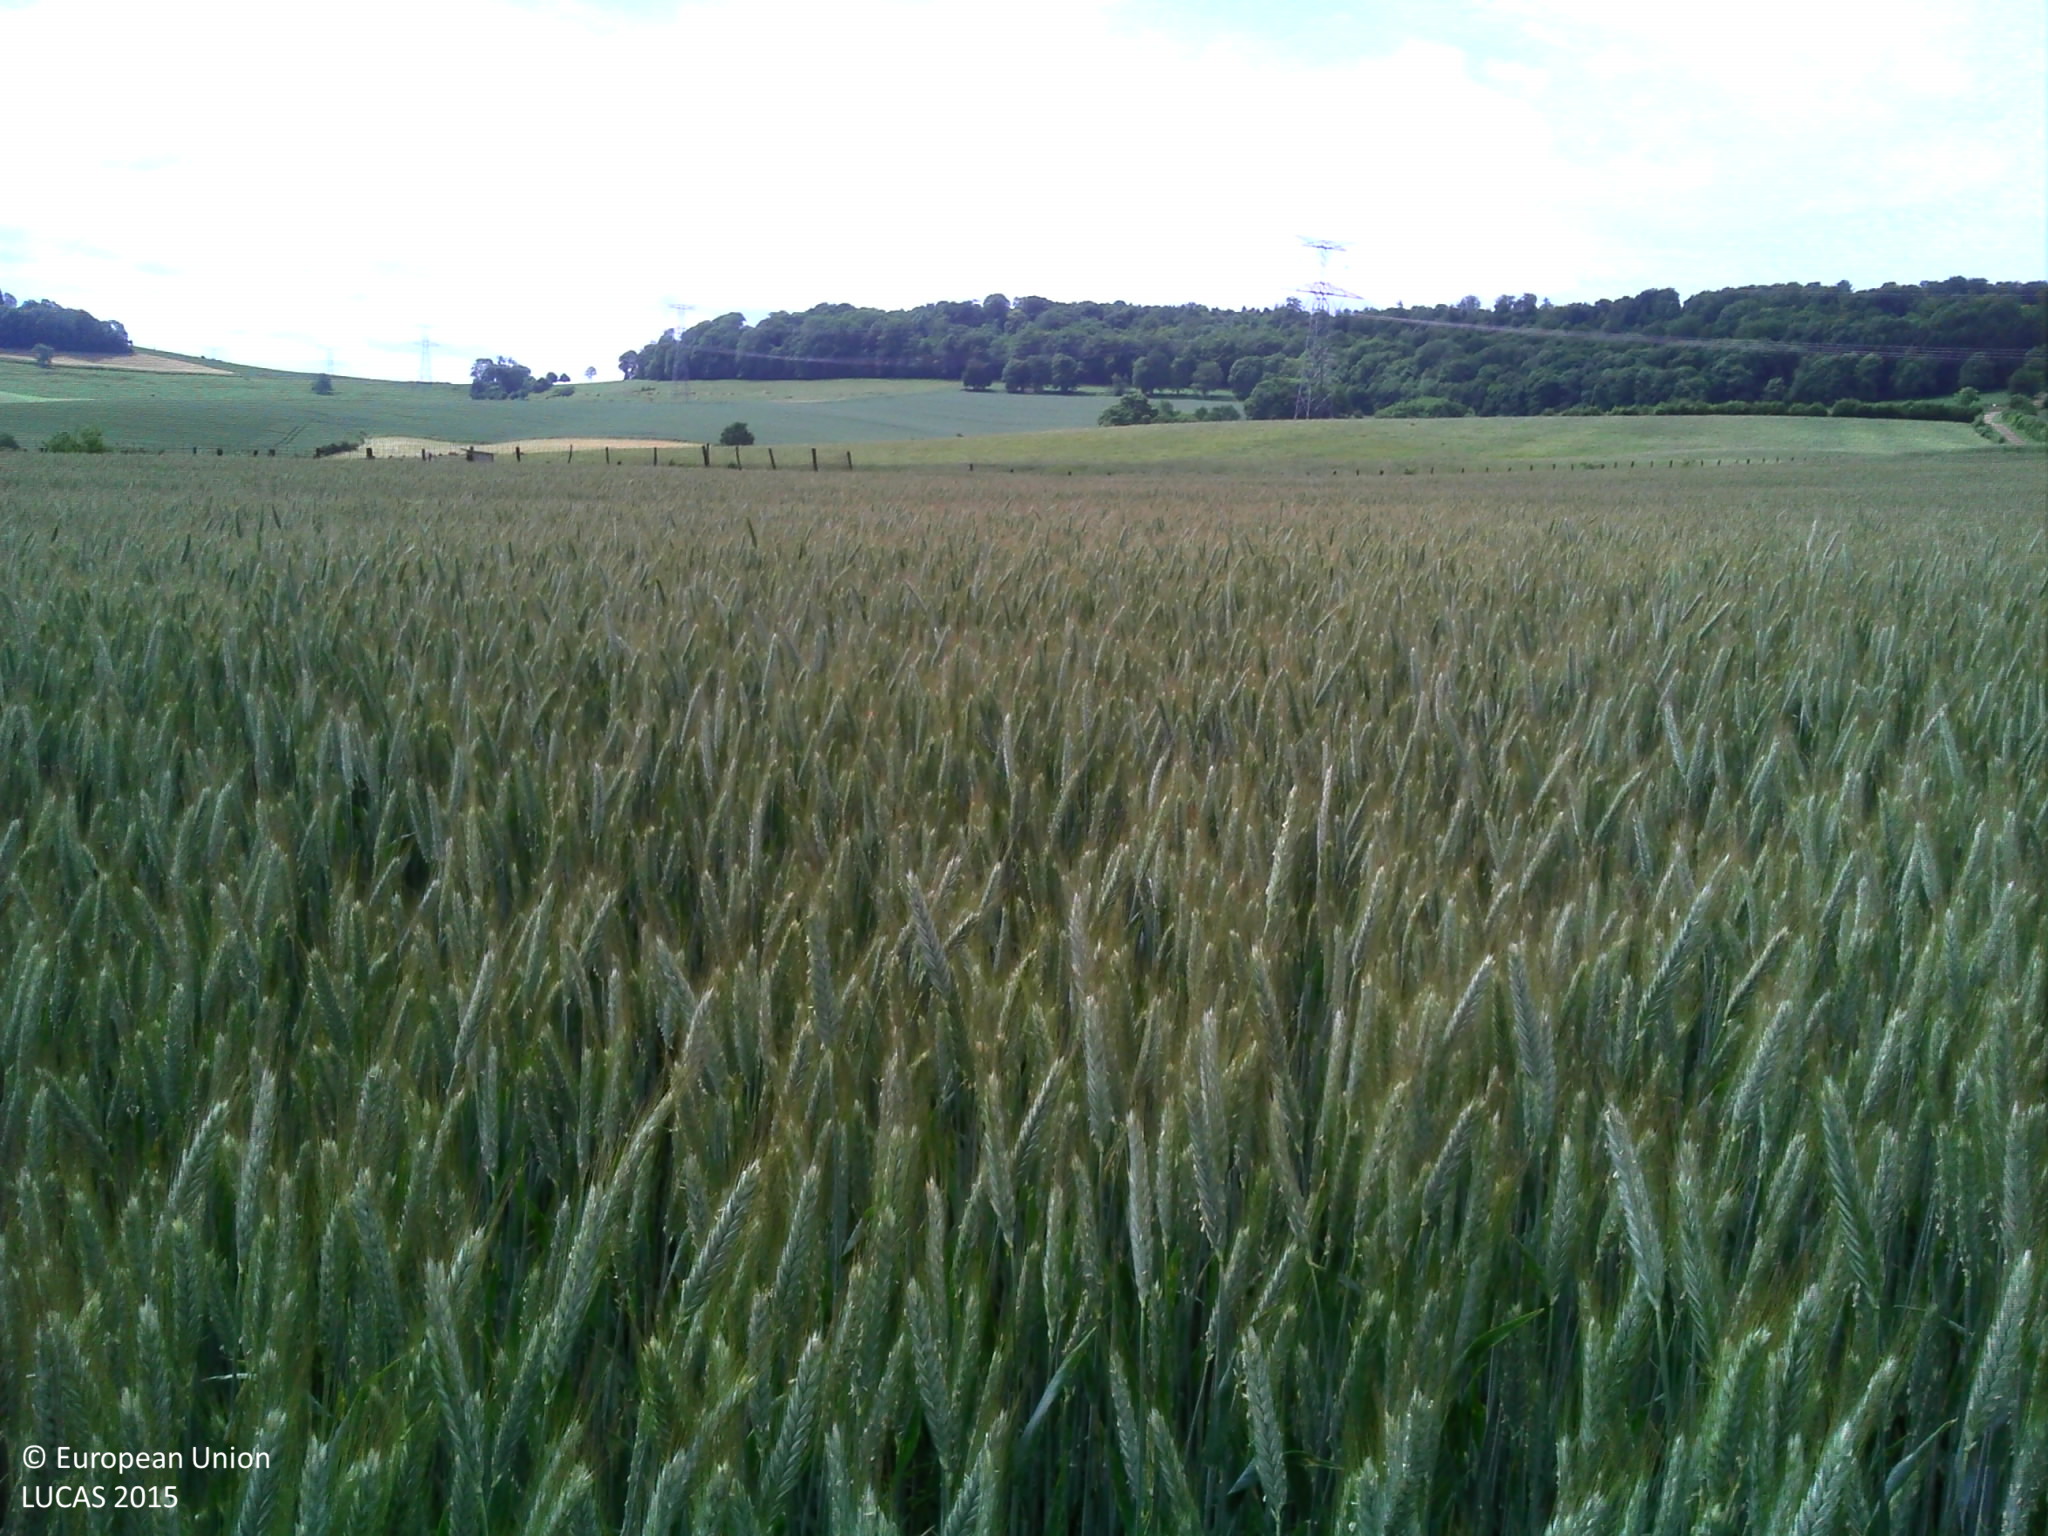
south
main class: Cropland
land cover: Triticale
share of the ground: > 75 %
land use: Agriculture (excluding fallow land and kitchen gardens)
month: June
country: FR
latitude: 48.8245
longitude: 6.1997
